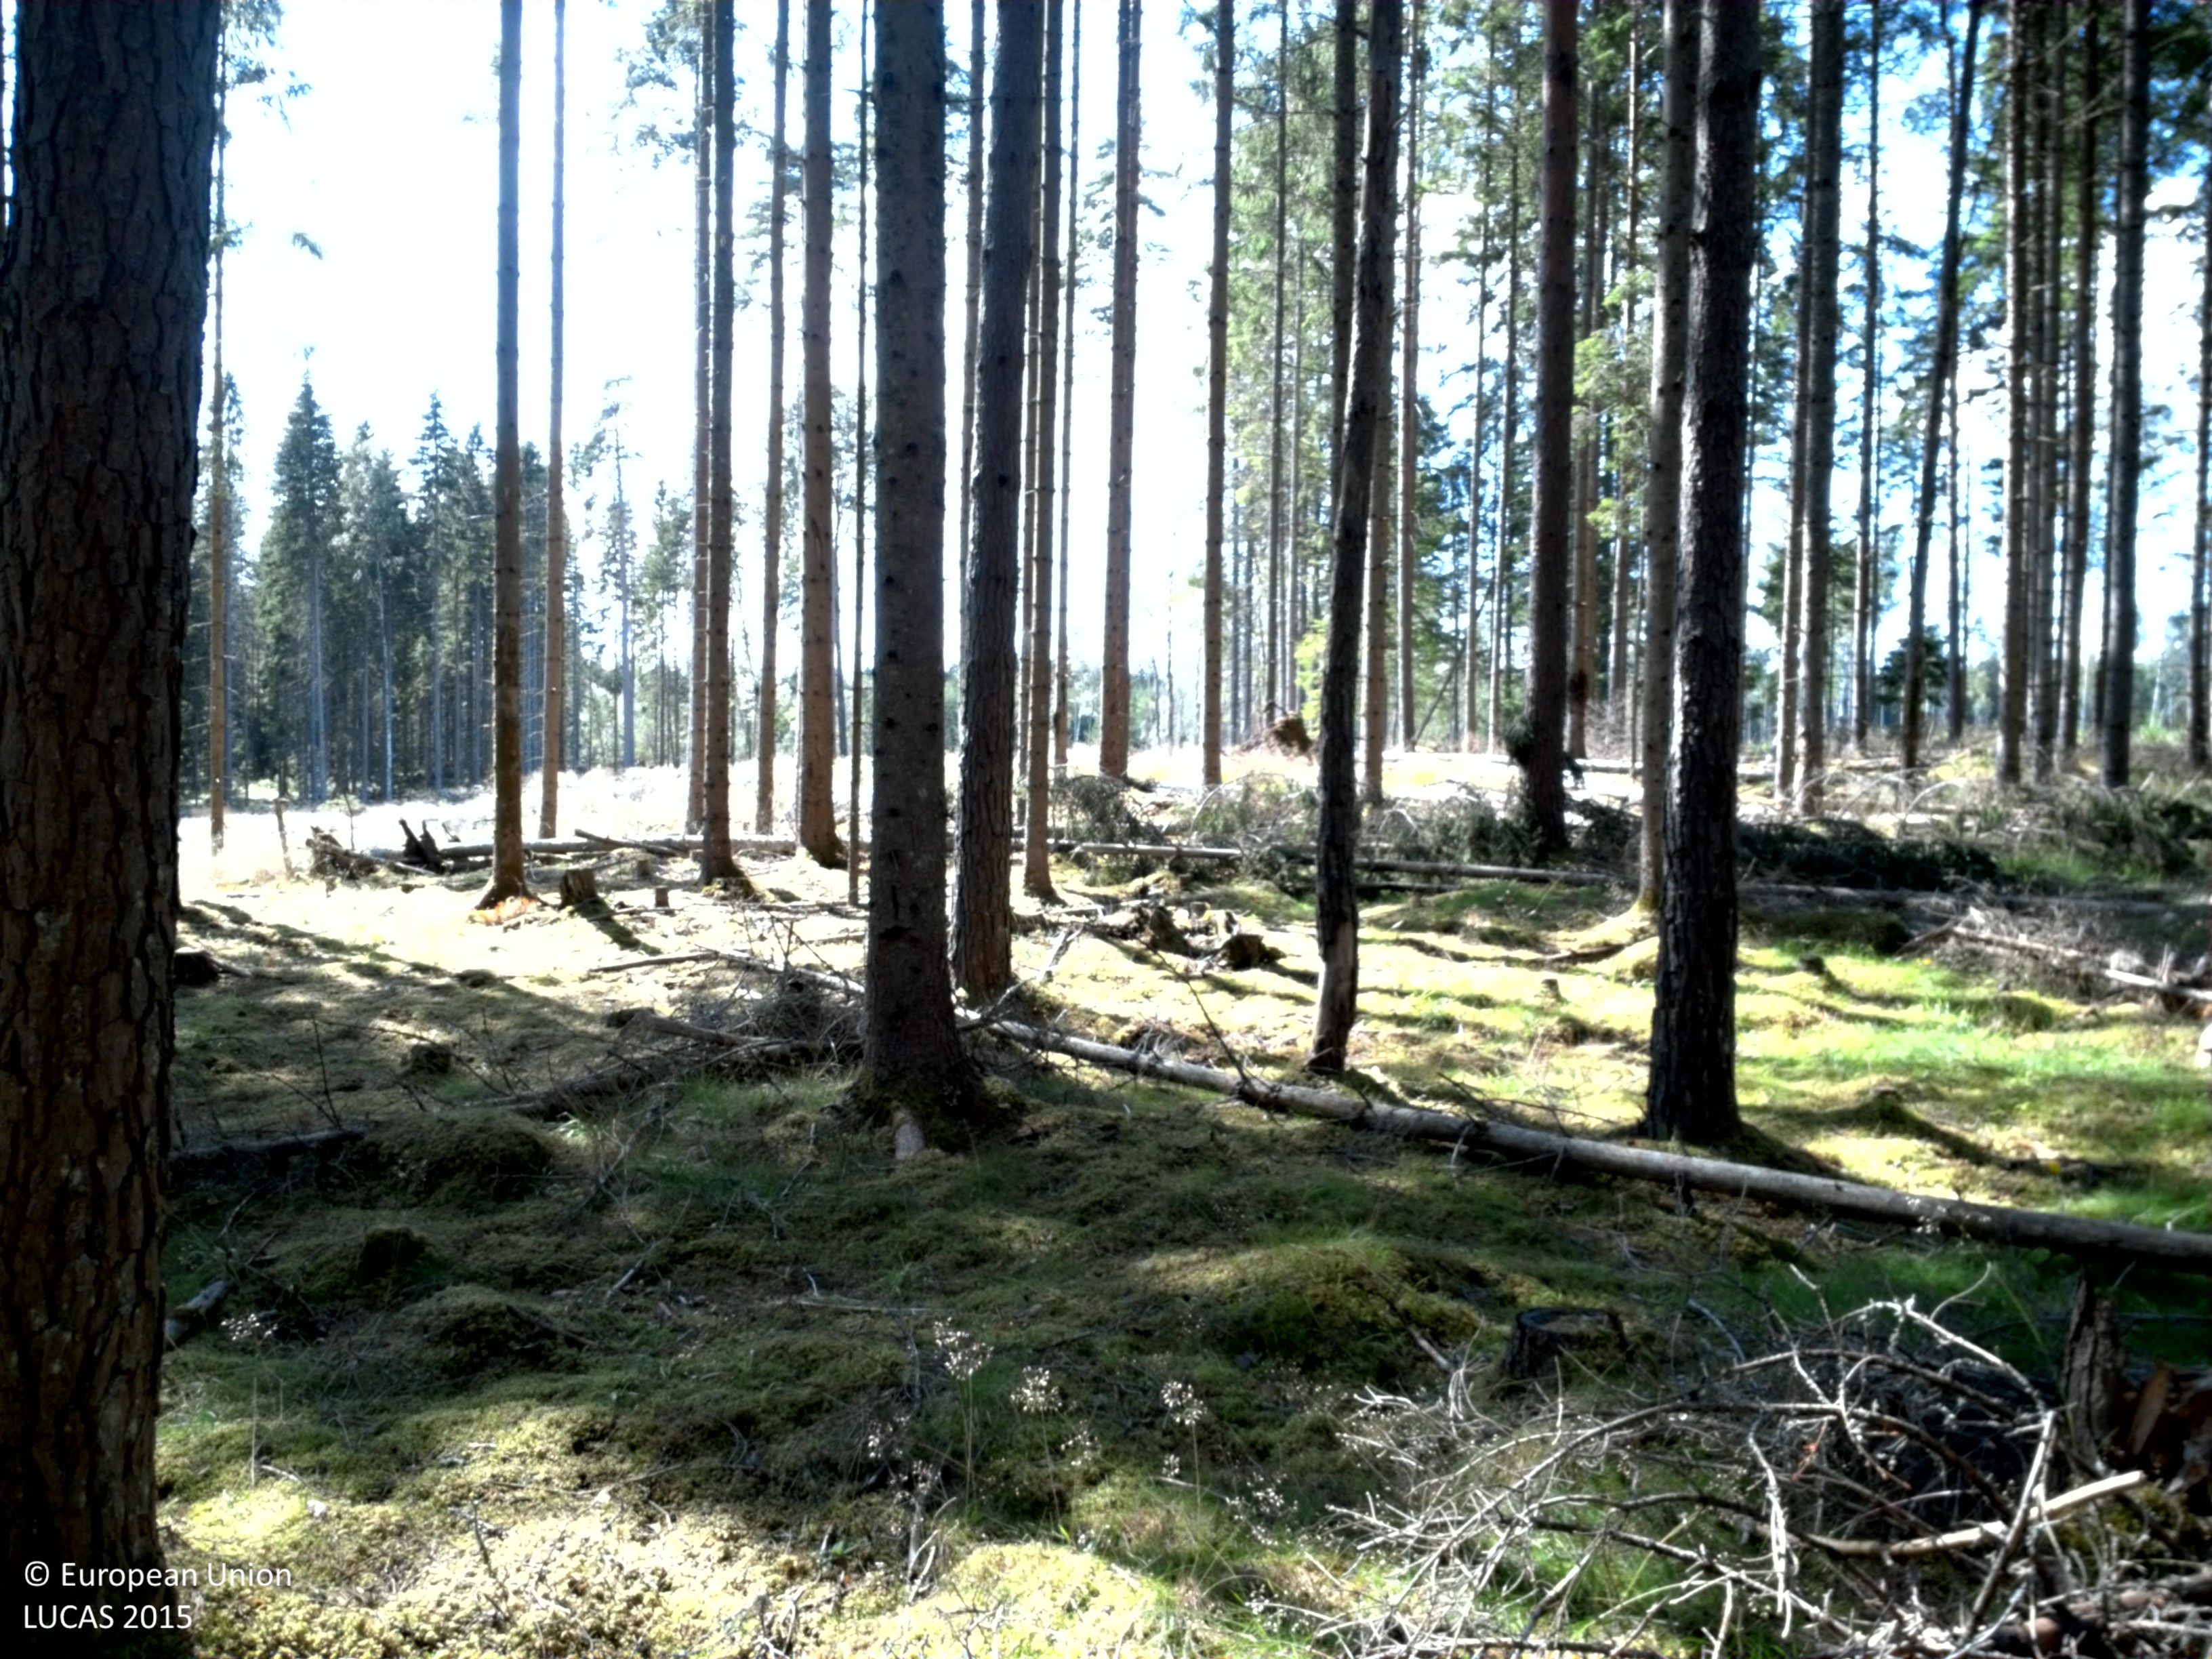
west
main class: Woodland
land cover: Spruce dominated coniferous woodland
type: boreal forest
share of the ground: 25 - 50 %
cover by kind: lichens and mosses 50 %, coniferous forest trees 40 %, herbaceous plants 10 %
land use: Forestry
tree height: > 5 m
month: July
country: SE
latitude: 58.8125
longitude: 15.4469
